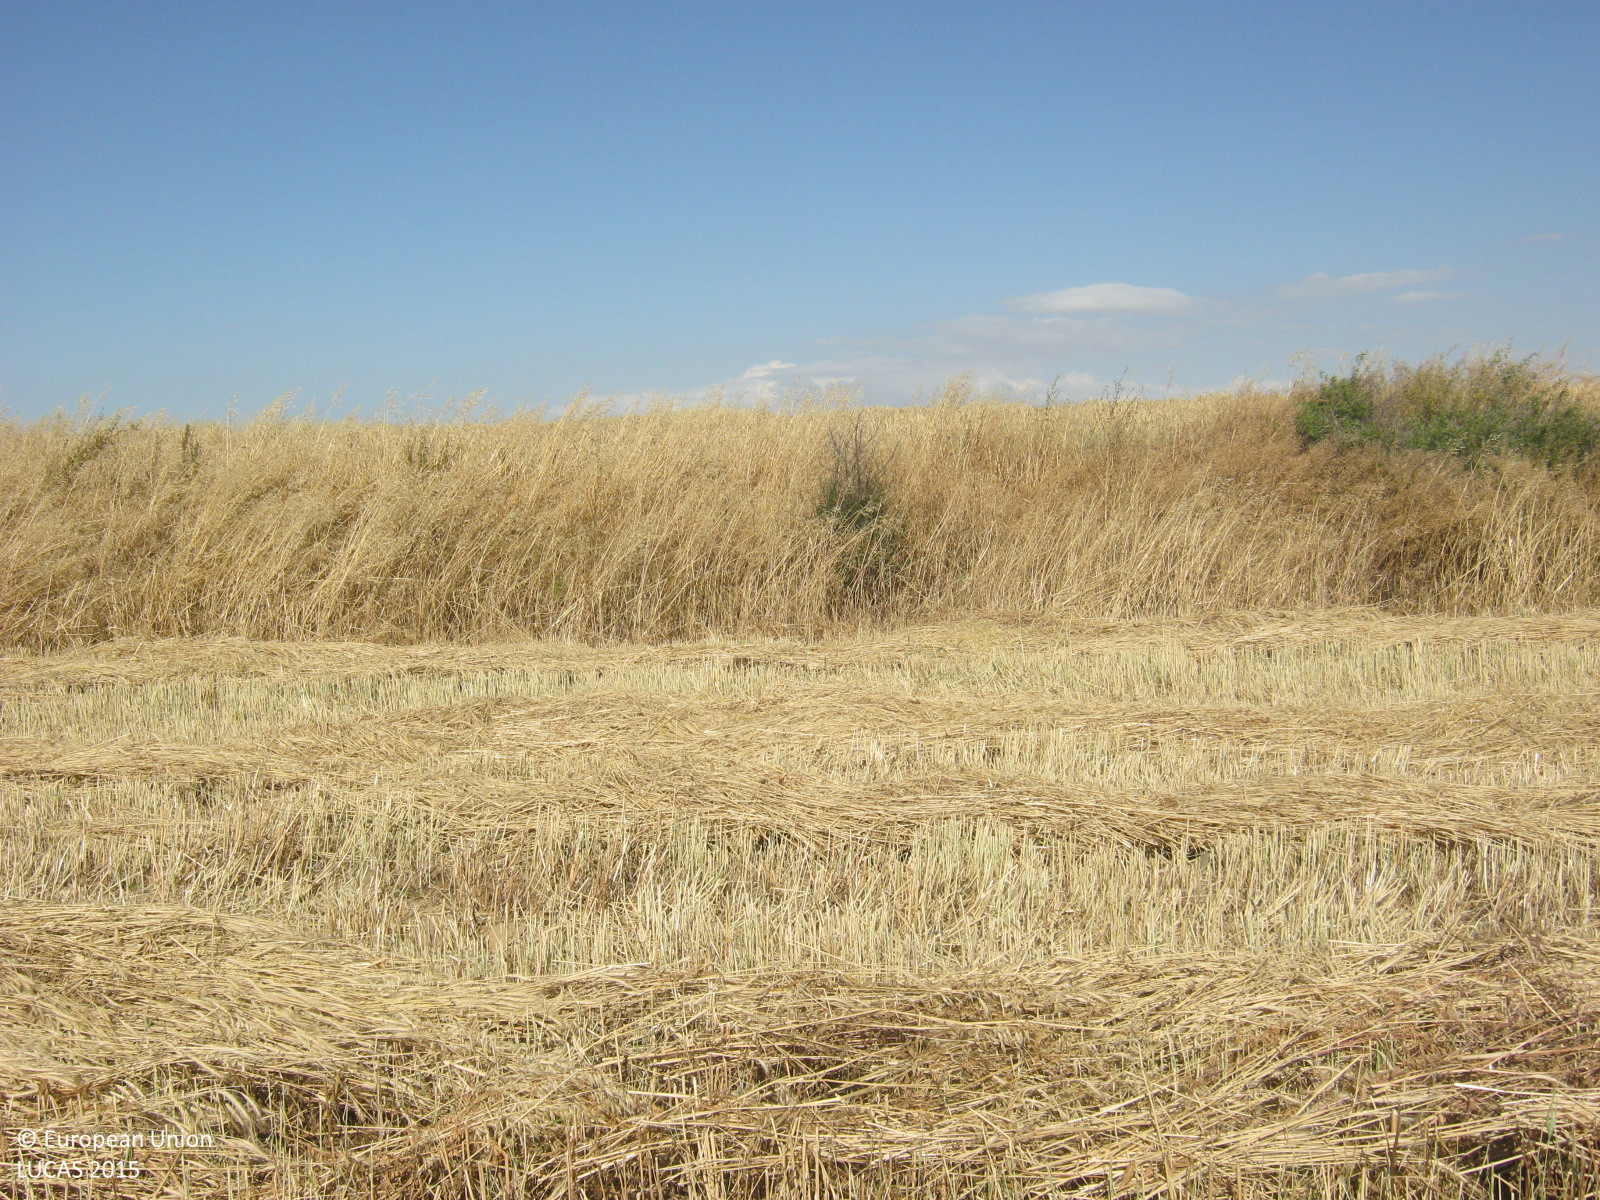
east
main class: Cropland
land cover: Barley
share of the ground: < 10 %
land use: Agriculture (excluding fallow land and kitchen gardens)
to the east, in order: Barley; Grassland without tree/shrub cover; Common wheat; Tracks; Other bare soil; Common wheat; Other bare soil; Grass margins; Other bare soil
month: May
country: CY
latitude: 35.1299
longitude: 33.1531
